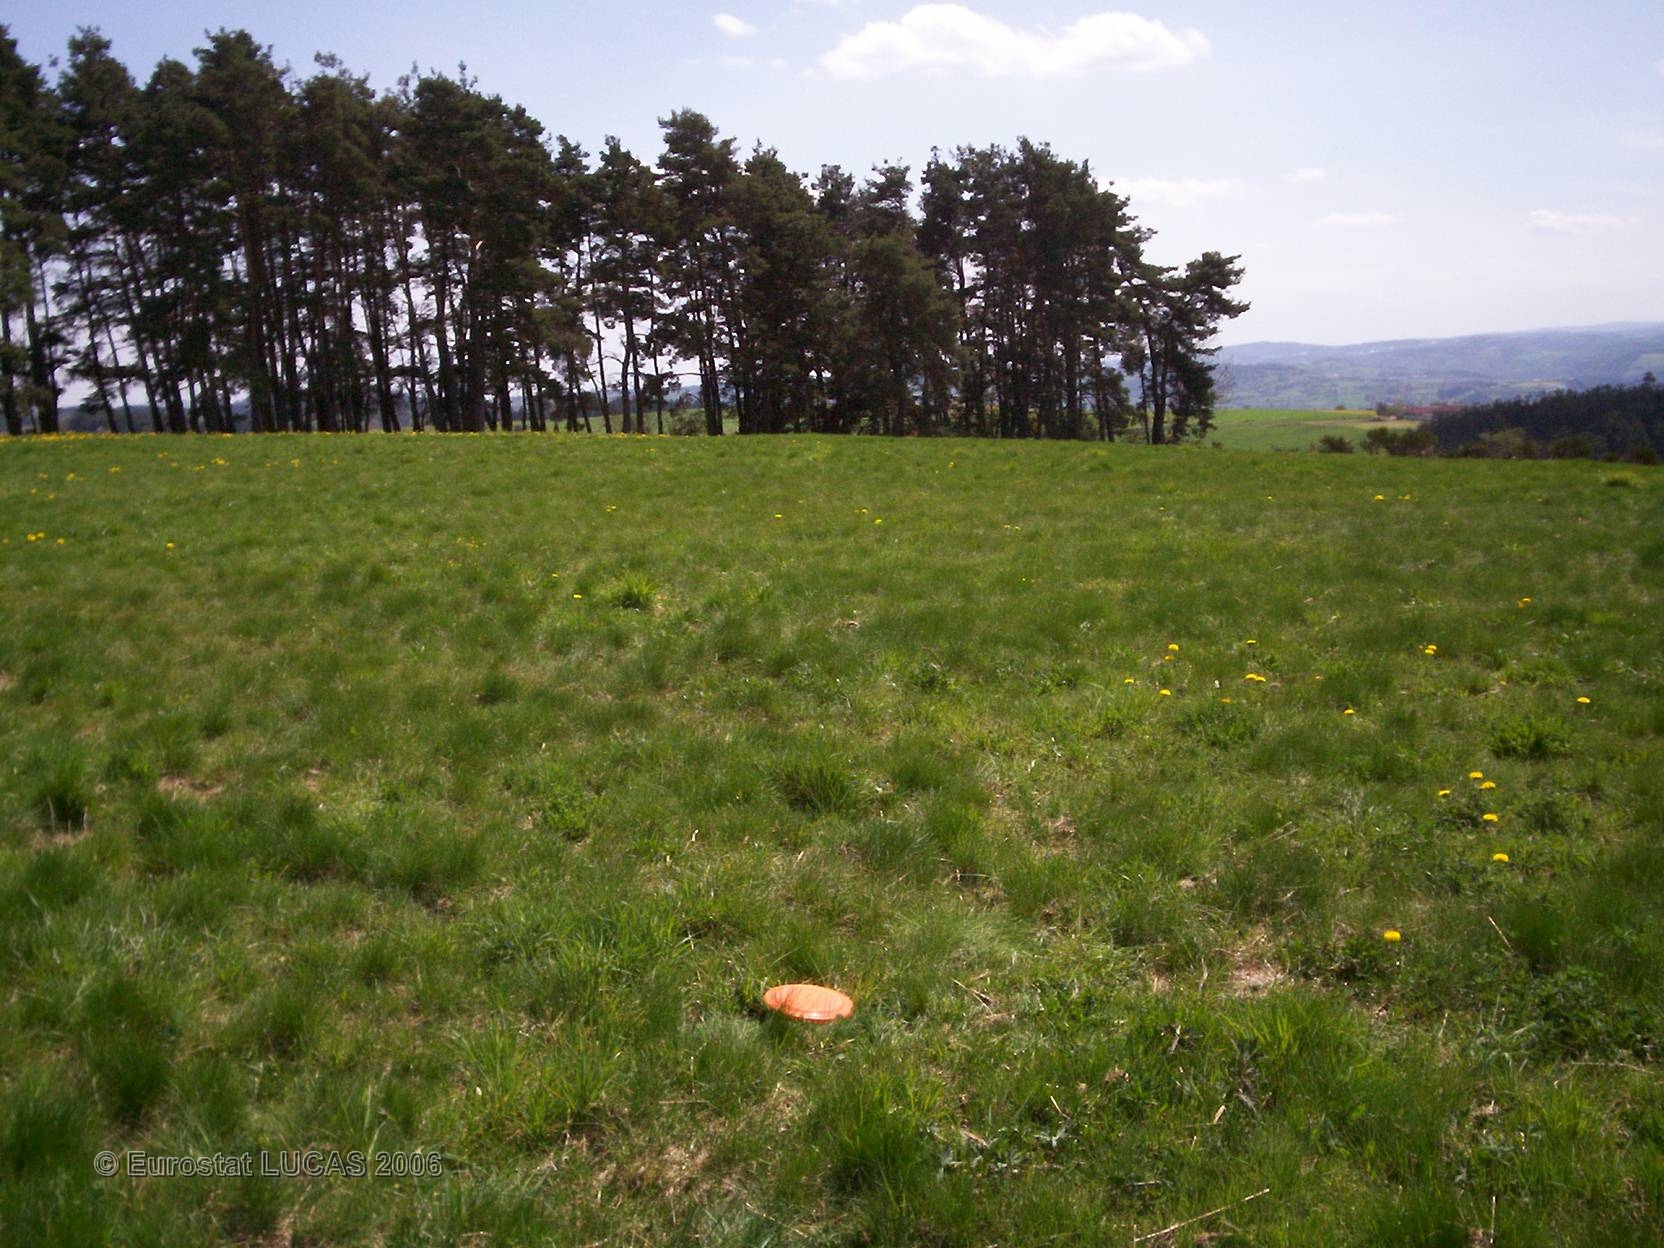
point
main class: Grassland
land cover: Grassland without tree/shrub cover
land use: Agriculture (excluding fallow land and kitchen gardens)
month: May
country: FR
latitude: 44.9821
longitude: 3.2689
